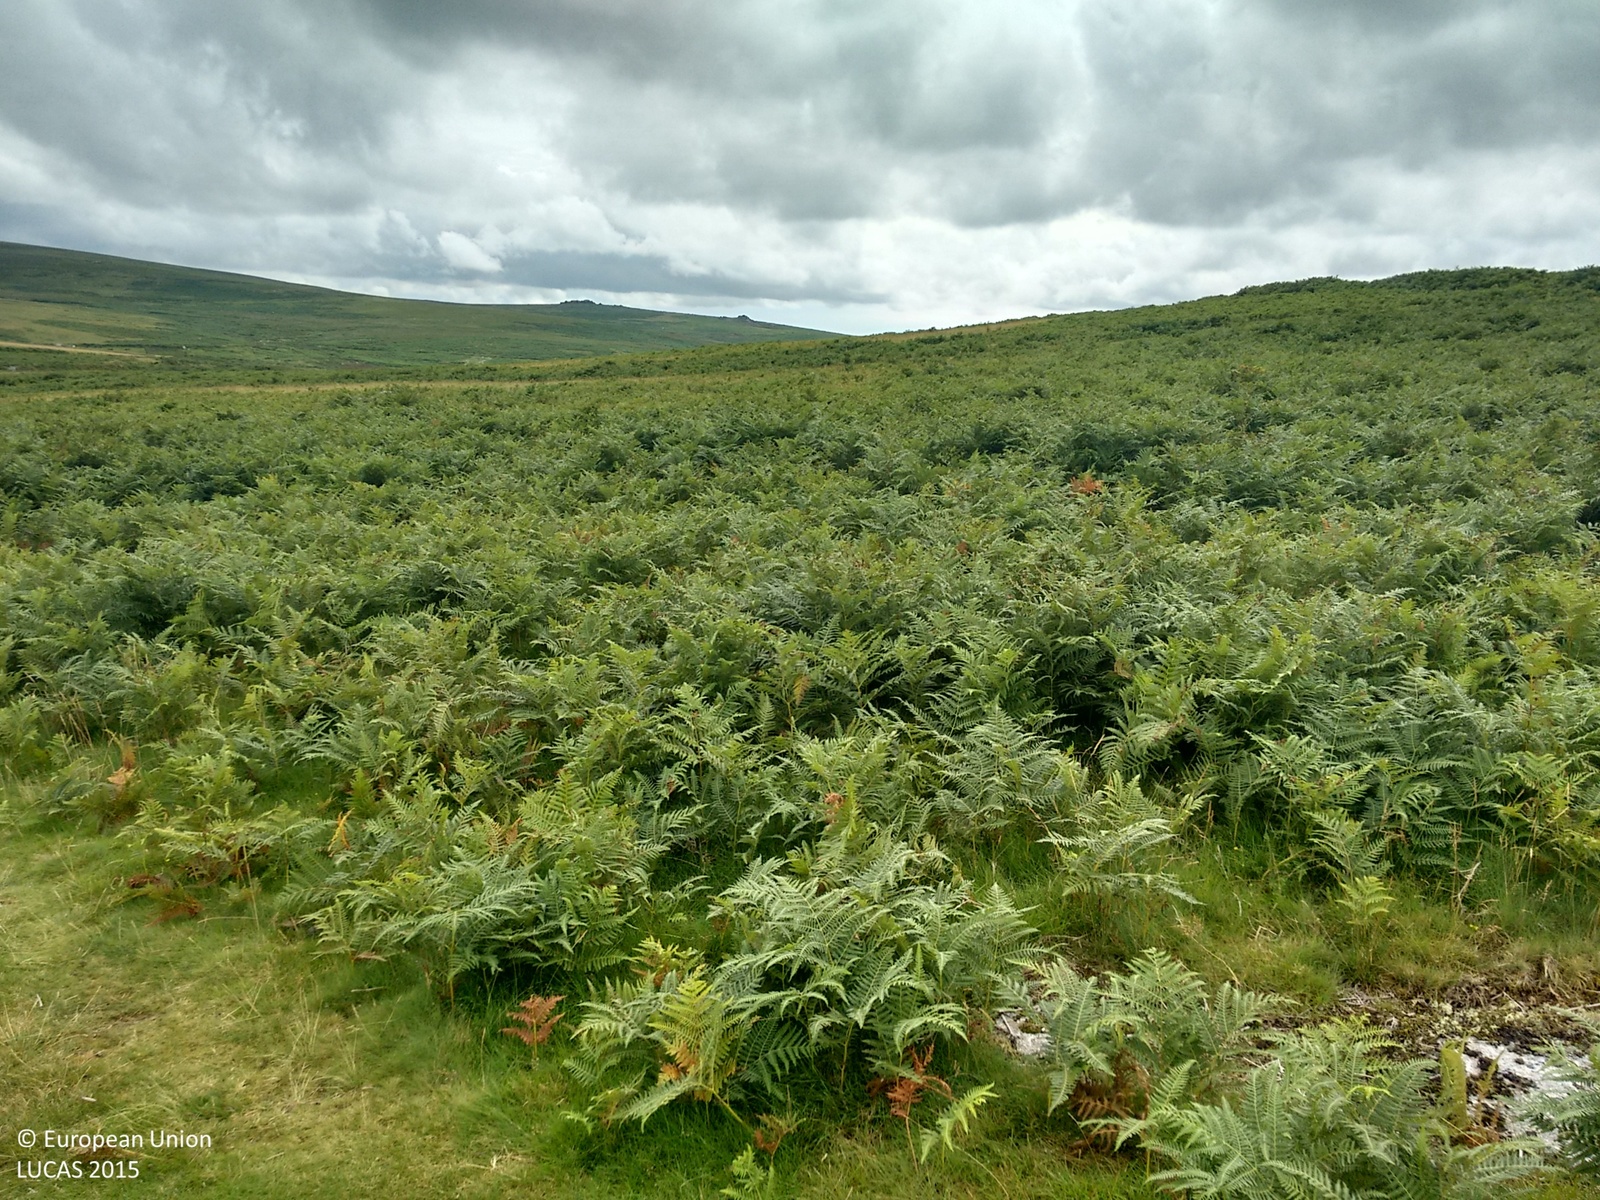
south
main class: Grassland
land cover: Grassland without tree/shrub cover
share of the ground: > 75 %
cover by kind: herbaceous plants 100 %
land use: Agriculture (excluding fallow land and kitchen gardens)
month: August
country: GB
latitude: 50.4829
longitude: -4.0037
